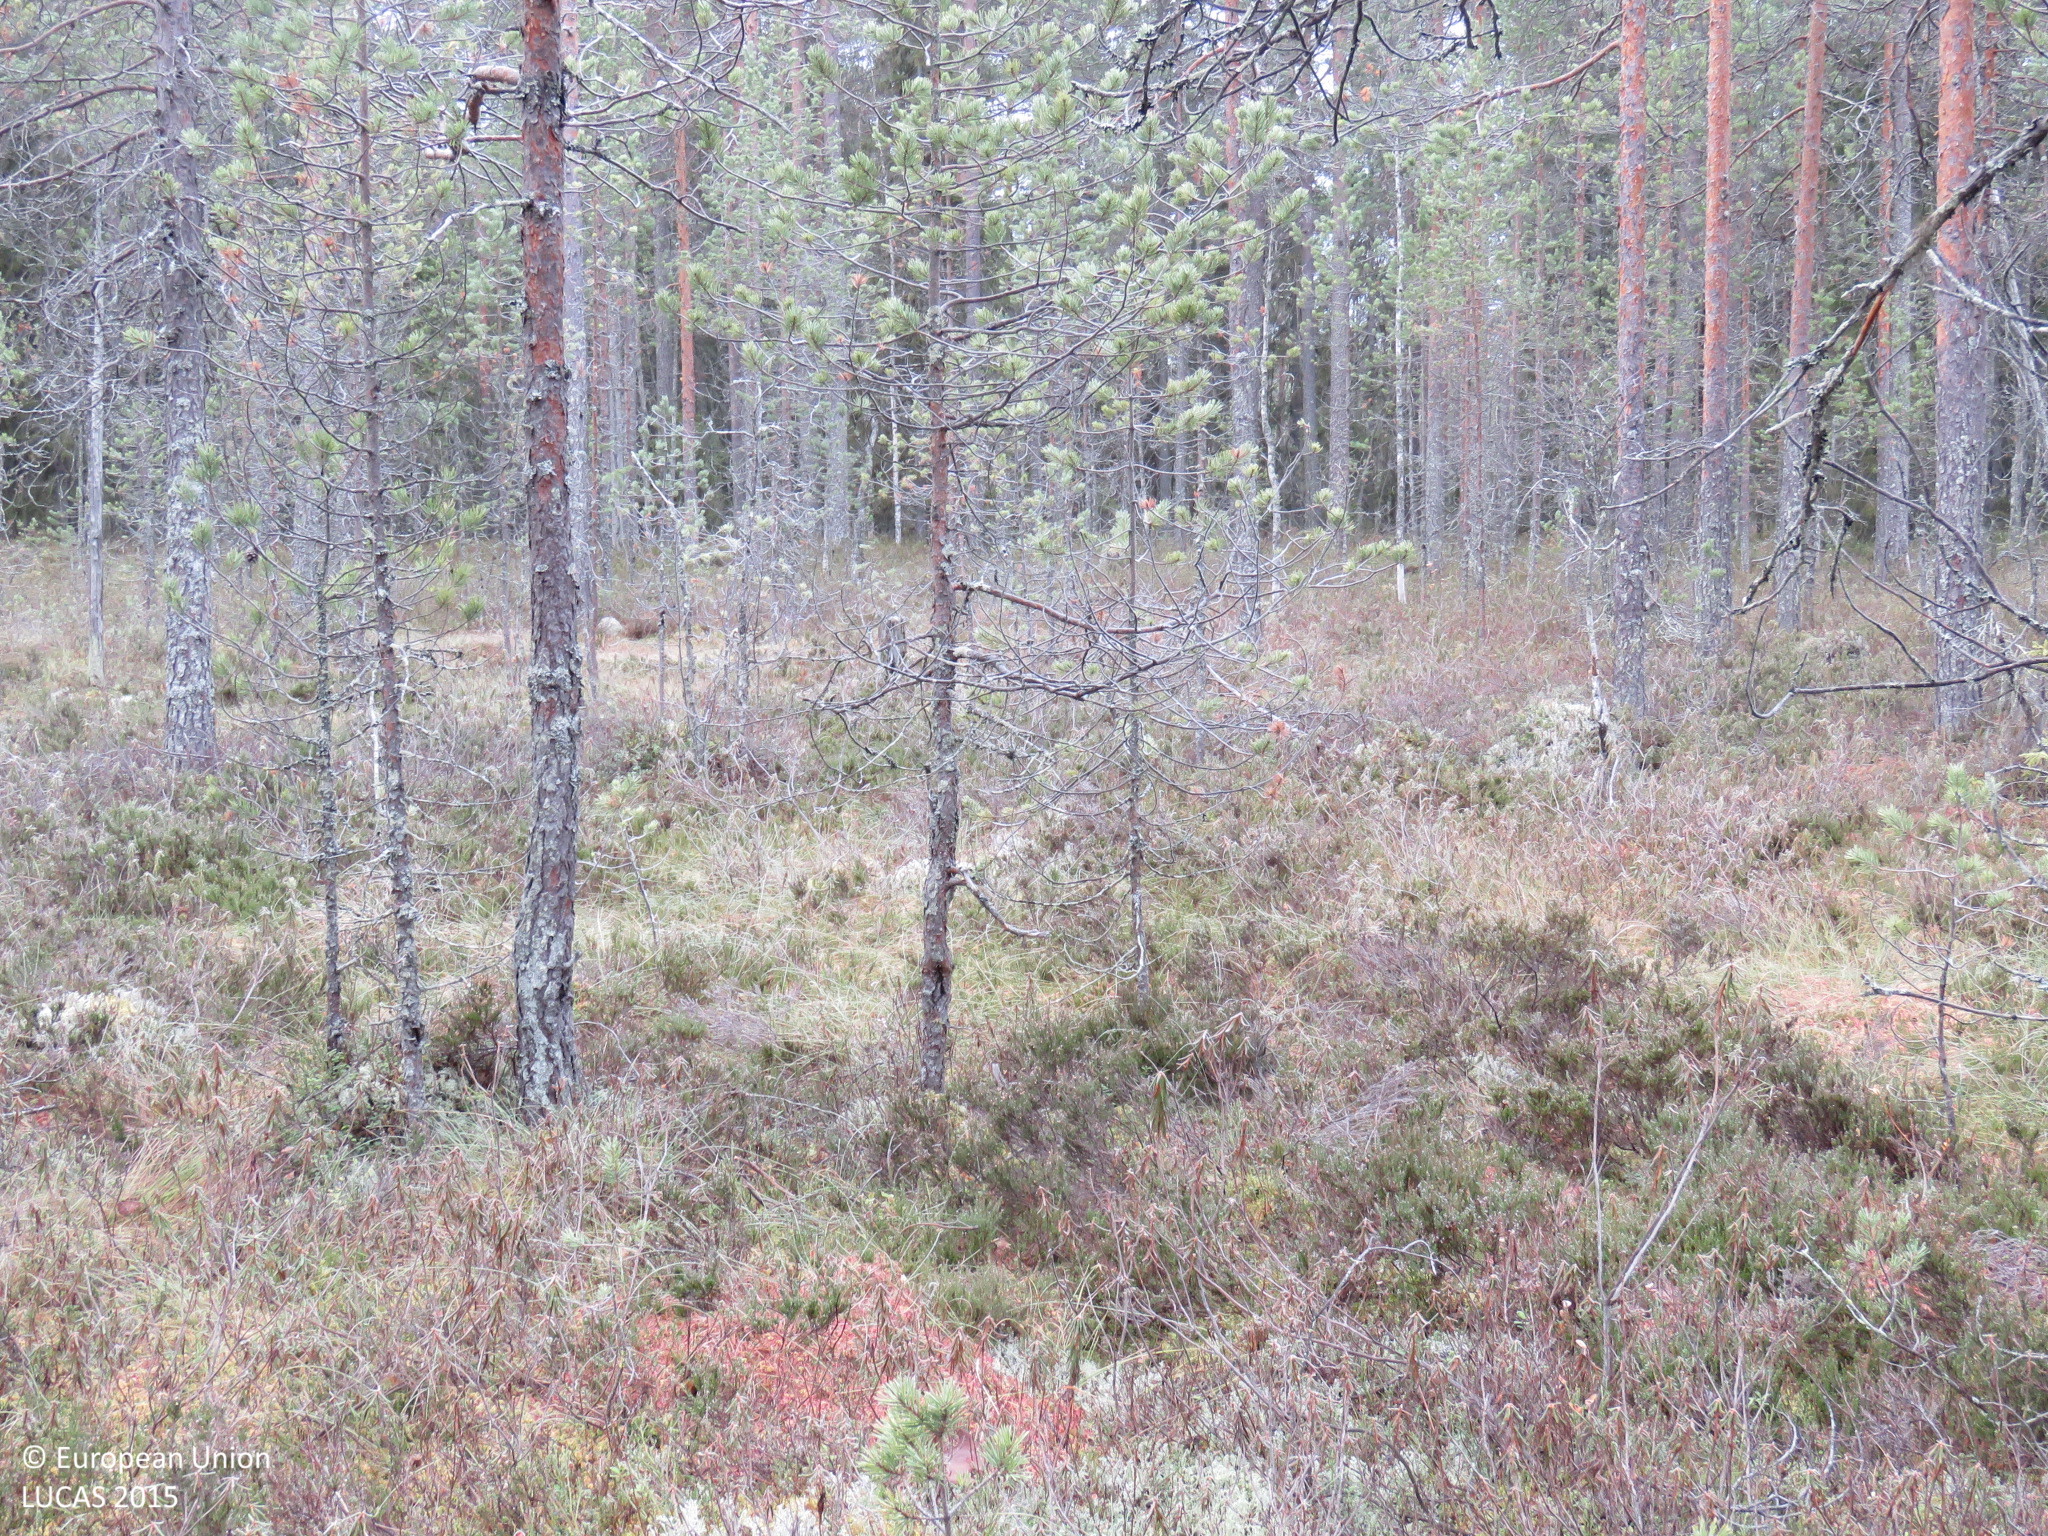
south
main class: Woodland
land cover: Pine dominated coniferous woodland
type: boreal forest
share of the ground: > 75 %
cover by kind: coniferous forest trees 75 %, shrubs 20 %, lichens and mosses 5 %
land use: Forestry
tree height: > 5 m
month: October
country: FI
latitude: 64.6261
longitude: 27.1343
